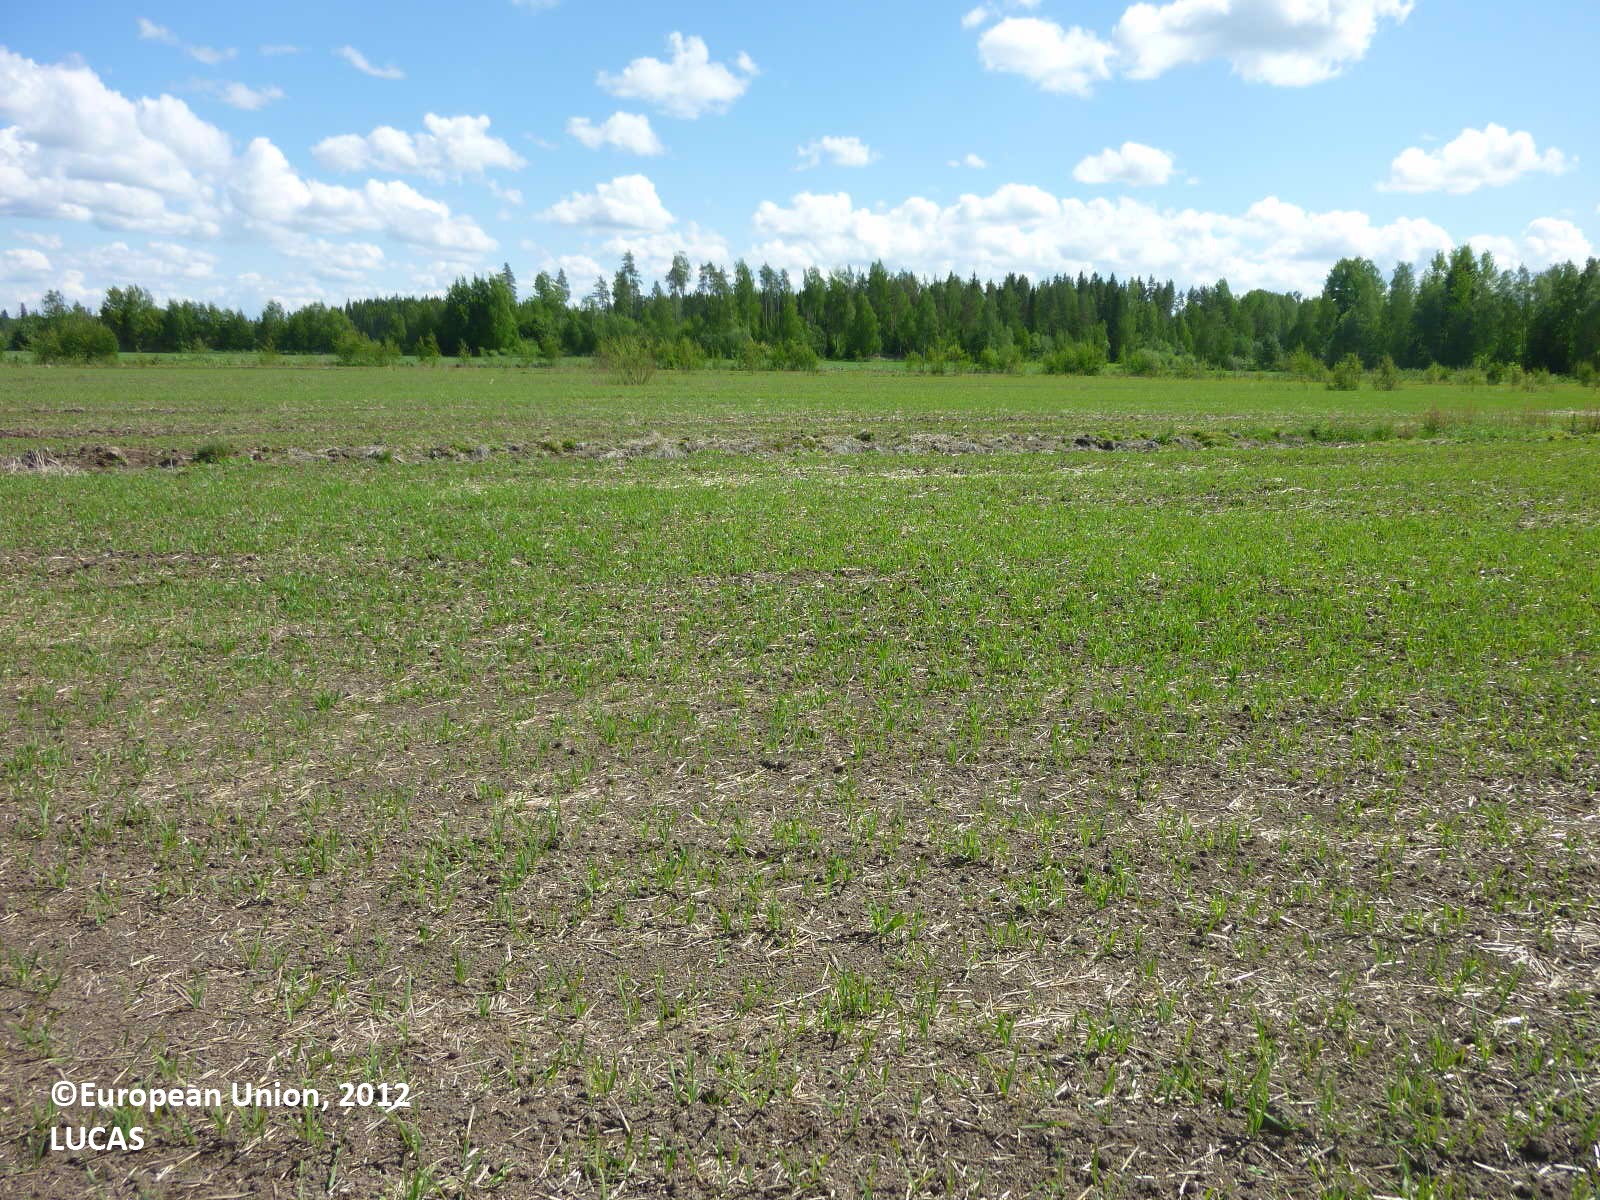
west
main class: Cropland
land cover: Barley
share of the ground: 50 - 75 %
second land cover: Grassland without tree/shrub cover
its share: > 75 %
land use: Agriculture (excluding fallow land and kitchen gardens)
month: June
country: FI
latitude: 61.4716
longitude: 22.6604
